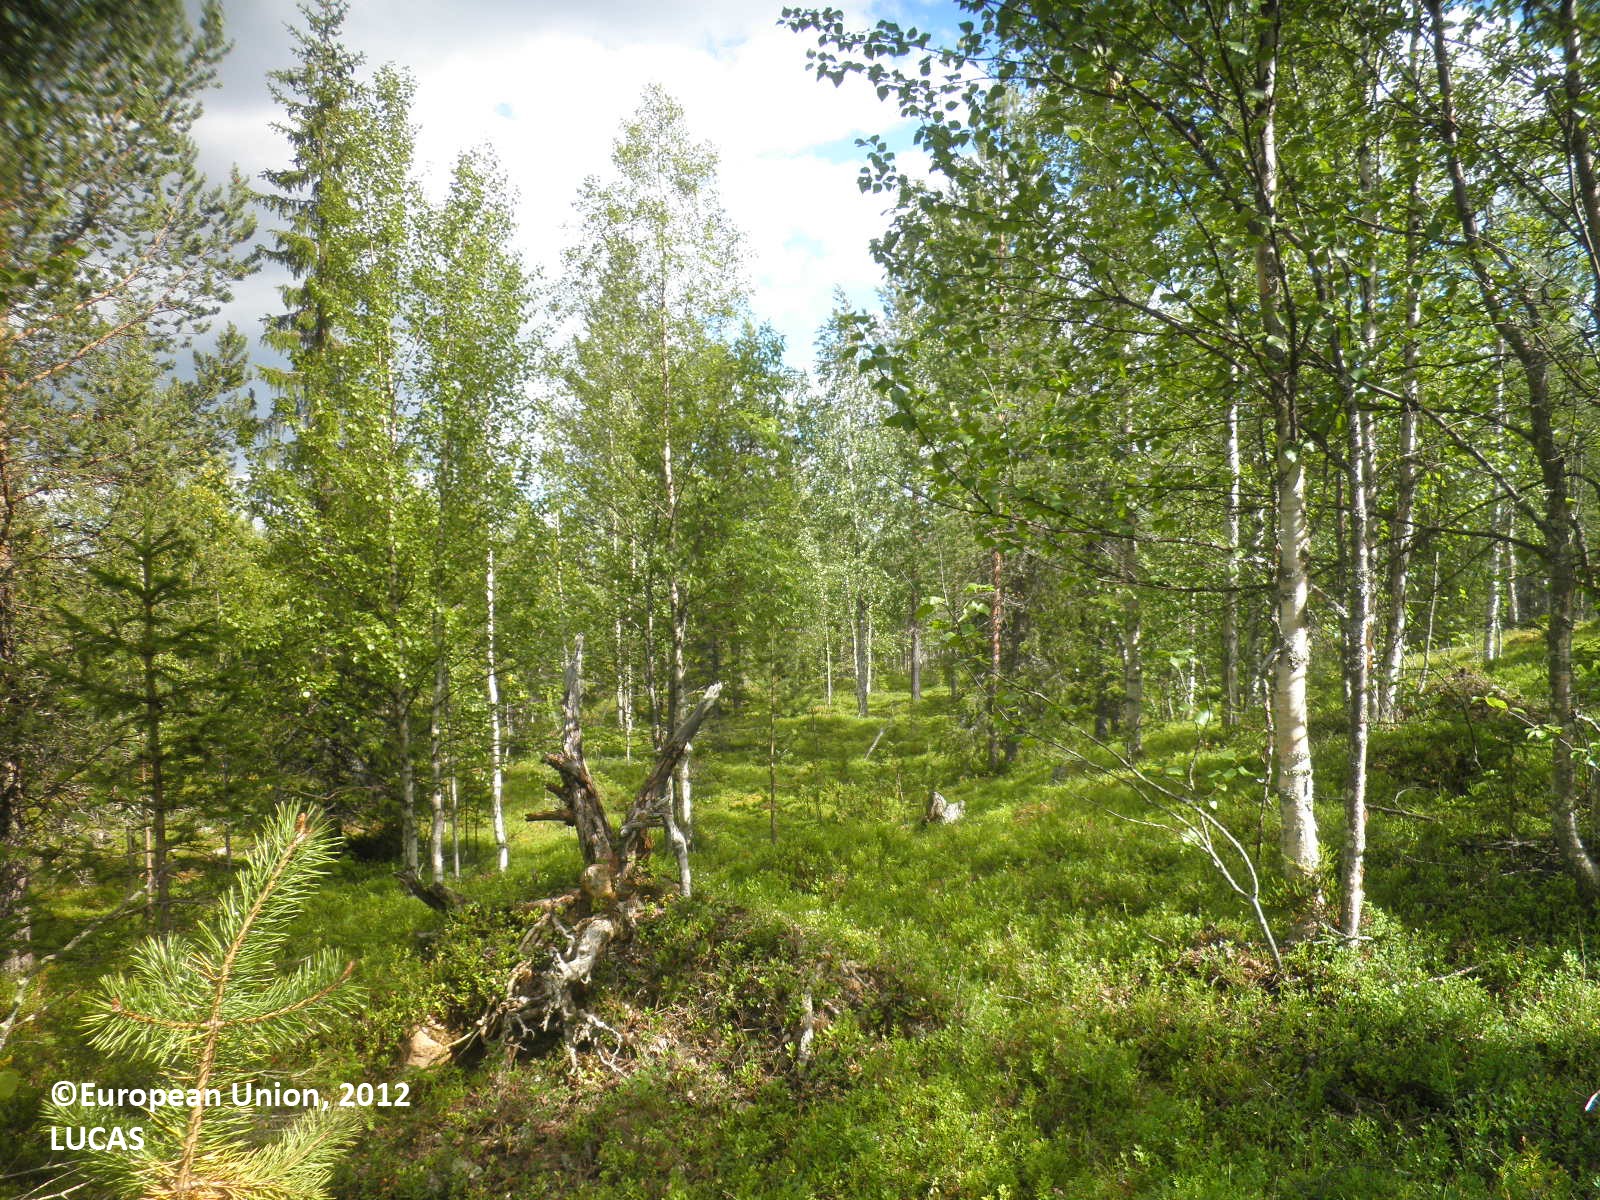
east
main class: Woodland
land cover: Spruce dominated mixed woodland
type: boreal forest
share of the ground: 50 - 75 %
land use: Forestry
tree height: > 5 m
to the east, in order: Spruce dominated mixed woodland; Pine dominated mixed woodland; Tracks; Pine dominated mixed woodland; Sand
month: July
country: FI
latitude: 67.6541
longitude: 25.8695
